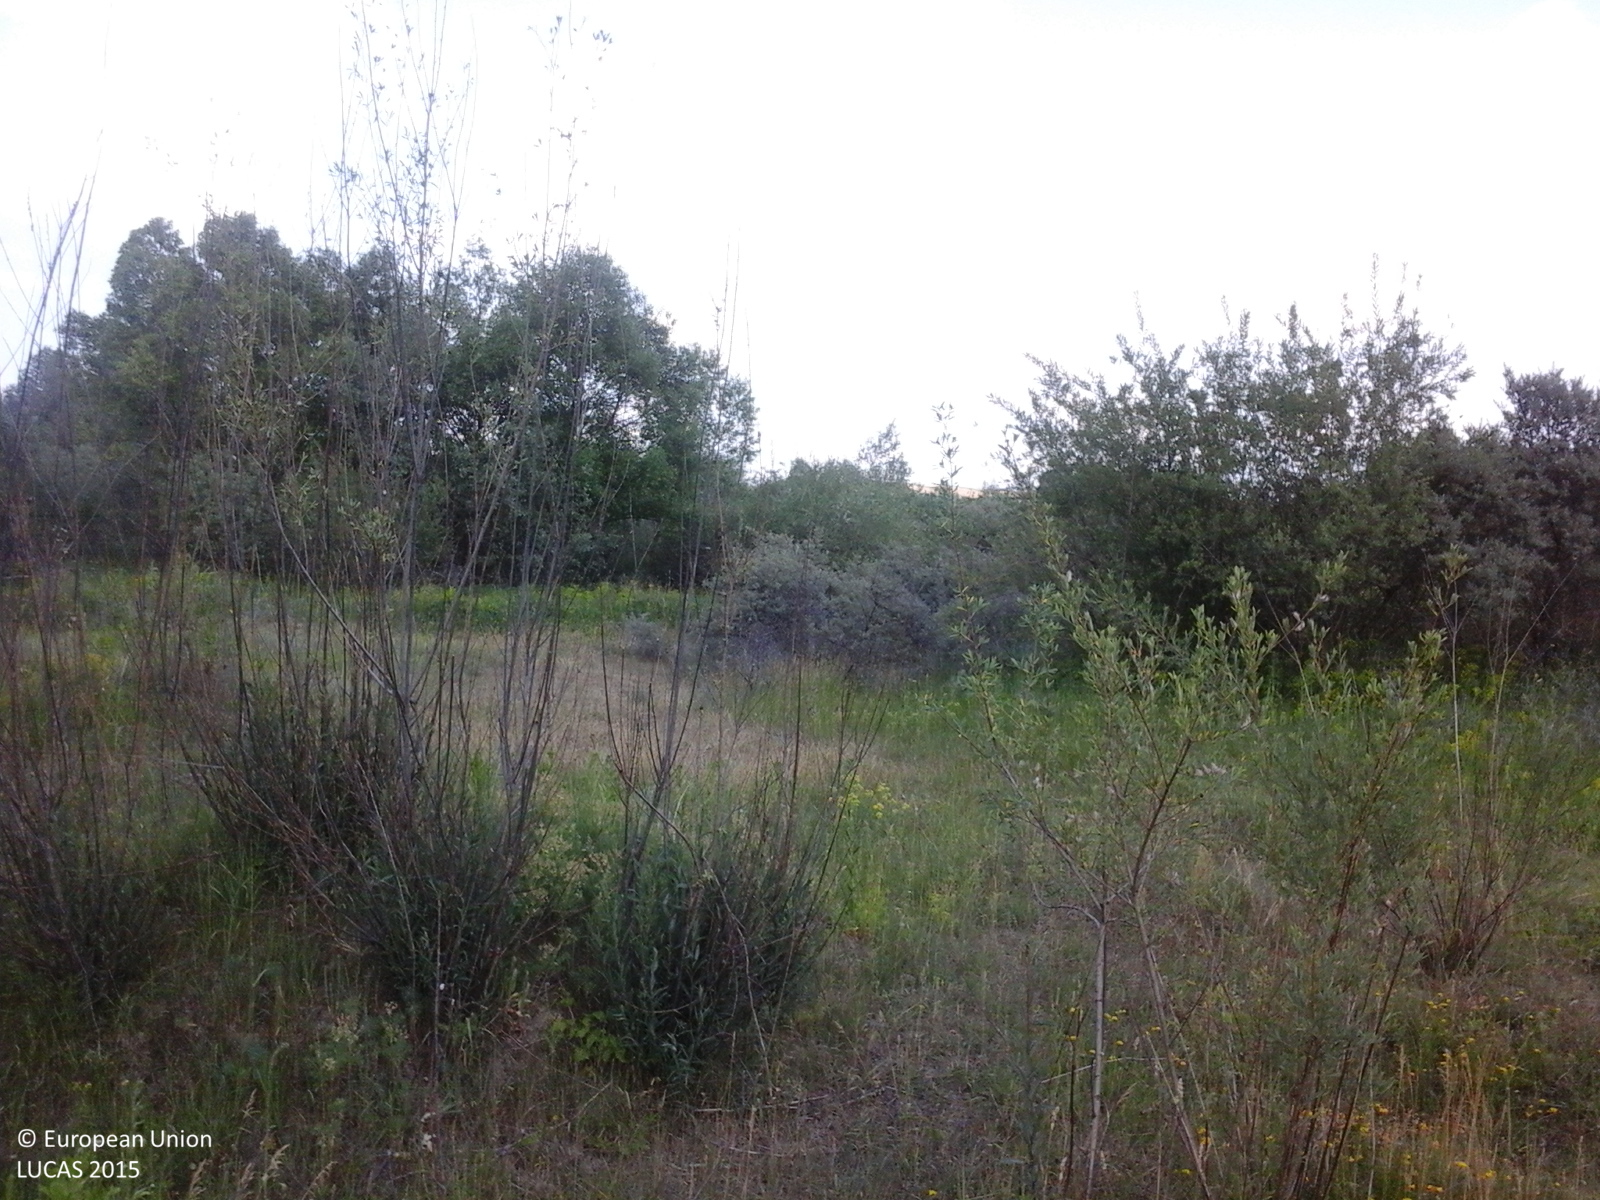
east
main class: Grassland
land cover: Grassland with sparse tree/shrub cover
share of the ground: > 75 %
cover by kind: herbaceous plants 90 %, broadleaved forest trees 5 %, shrubs 5 %
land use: Agriculture (excluding fallow land and kitchen gardens)
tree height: < 5 m
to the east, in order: Tracks; Grassland with sparse tree/shrub cover; Shrubland with sparse tree cover; Broadleaved woodland; Ditches and canals; Broadleaved woodland; Grassland without tree/shrub cover; Broadleaved woodland; Grassland with sparse tree/shrub cover; Broadleaved woodland; Rivers and streams; Broadleaved woodland; Grass margins; Maize
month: June
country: RO
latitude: 46.4791
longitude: 26.6944
